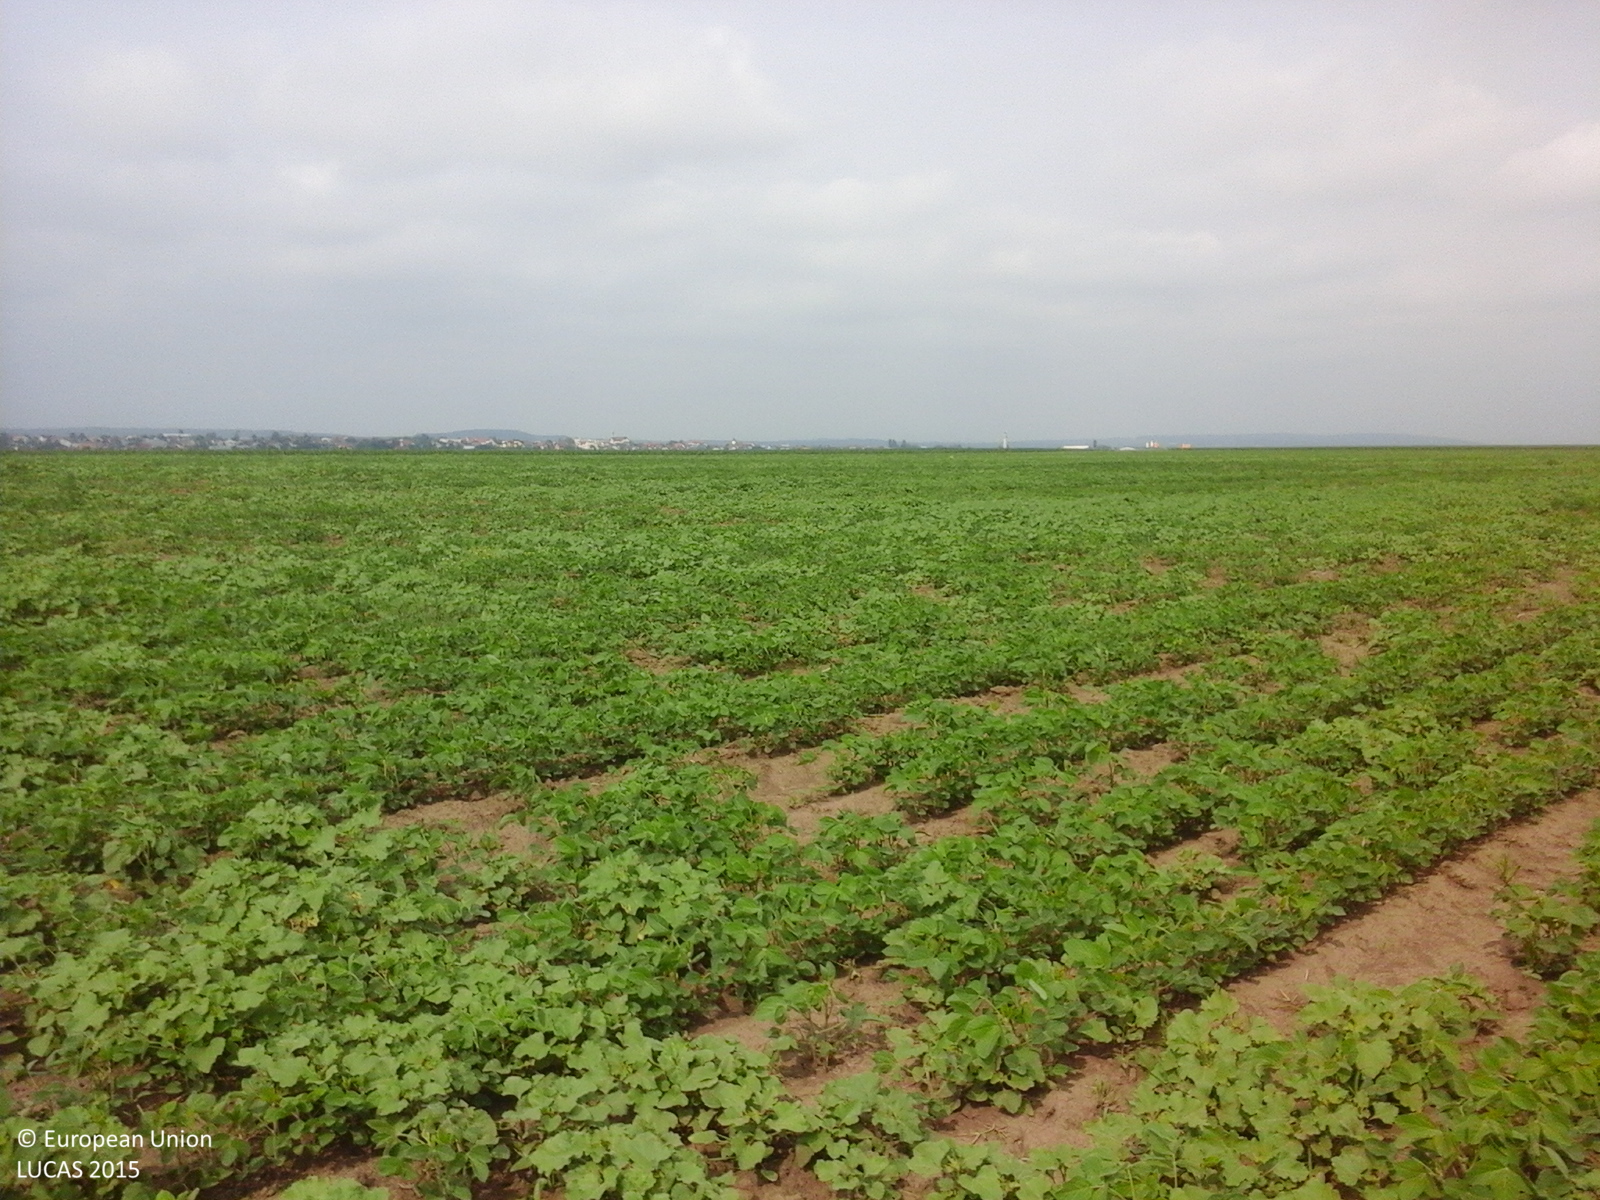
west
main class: Cropland
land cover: Soya
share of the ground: 50 - 75 %
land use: Agriculture (excluding fallow land and kitchen gardens)
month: June
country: RO
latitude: 47.7754
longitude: 26.6287
